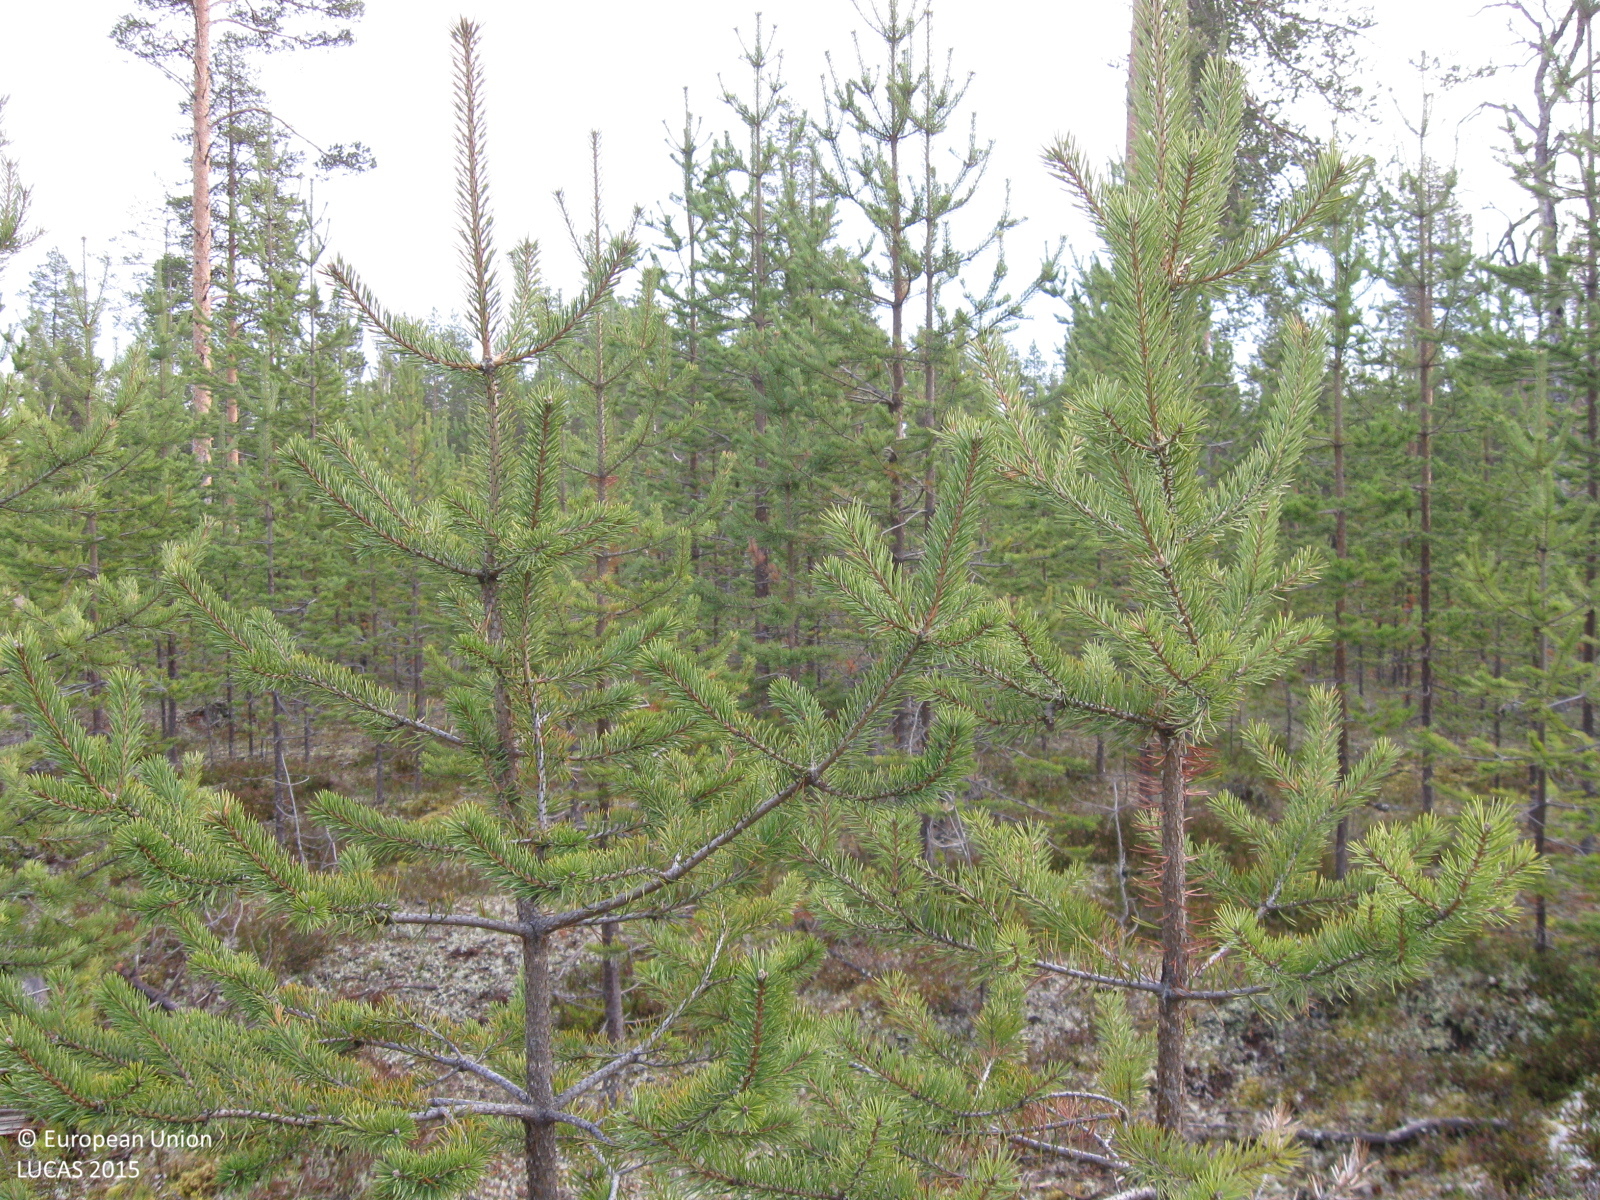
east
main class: Woodland
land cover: Pine dominated coniferous woodland
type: boreal forest
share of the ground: 50 - 75 %
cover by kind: coniferous forest trees 65 %, shrubs 15 %, lichens and mosses 10 %, herbaceous plants 5 %
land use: Forestry
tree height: < 5 m
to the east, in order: Pine dominated coniferous woodland; Other coniferous woodland; Pine dominated coniferous woodland
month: November
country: SE
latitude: 66.0532
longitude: 20.5817
